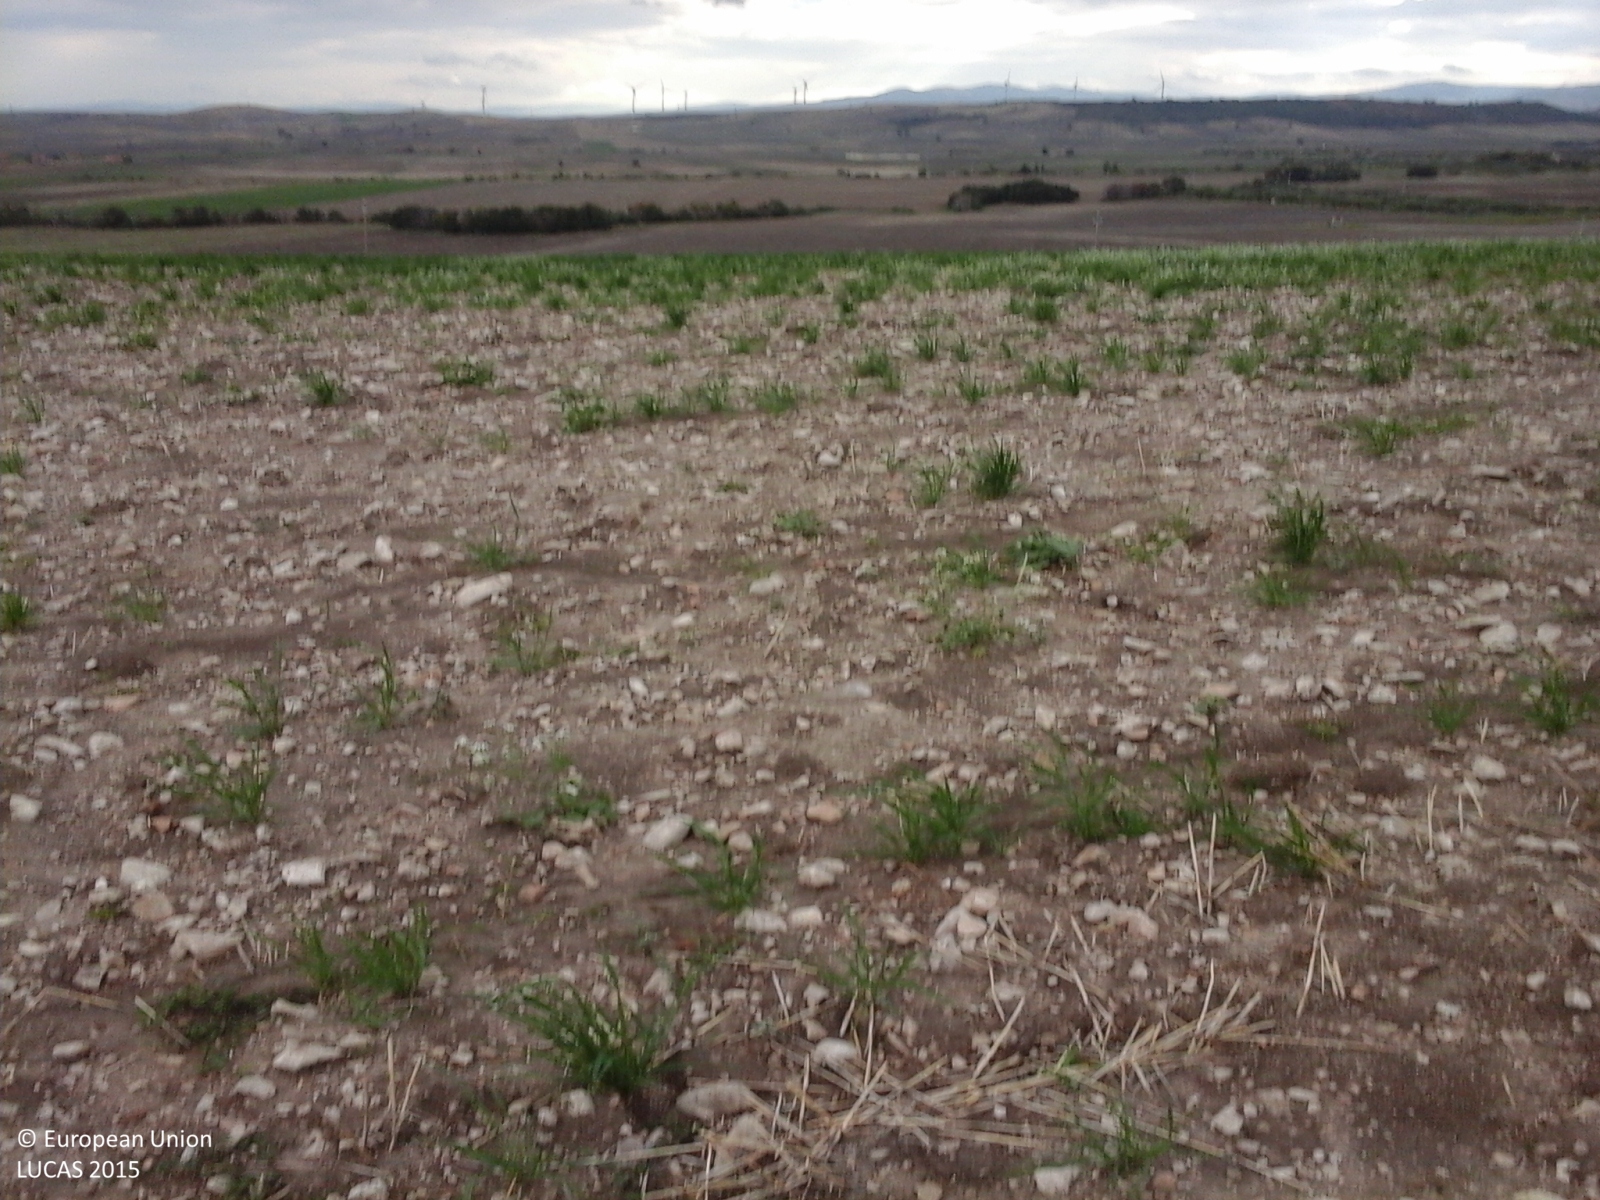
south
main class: Cropland
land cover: Durum wheat
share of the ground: > 75 %
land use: Agriculture (excluding fallow land and kitchen gardens)
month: October
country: IT
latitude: 41.5611
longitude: 15.1988
